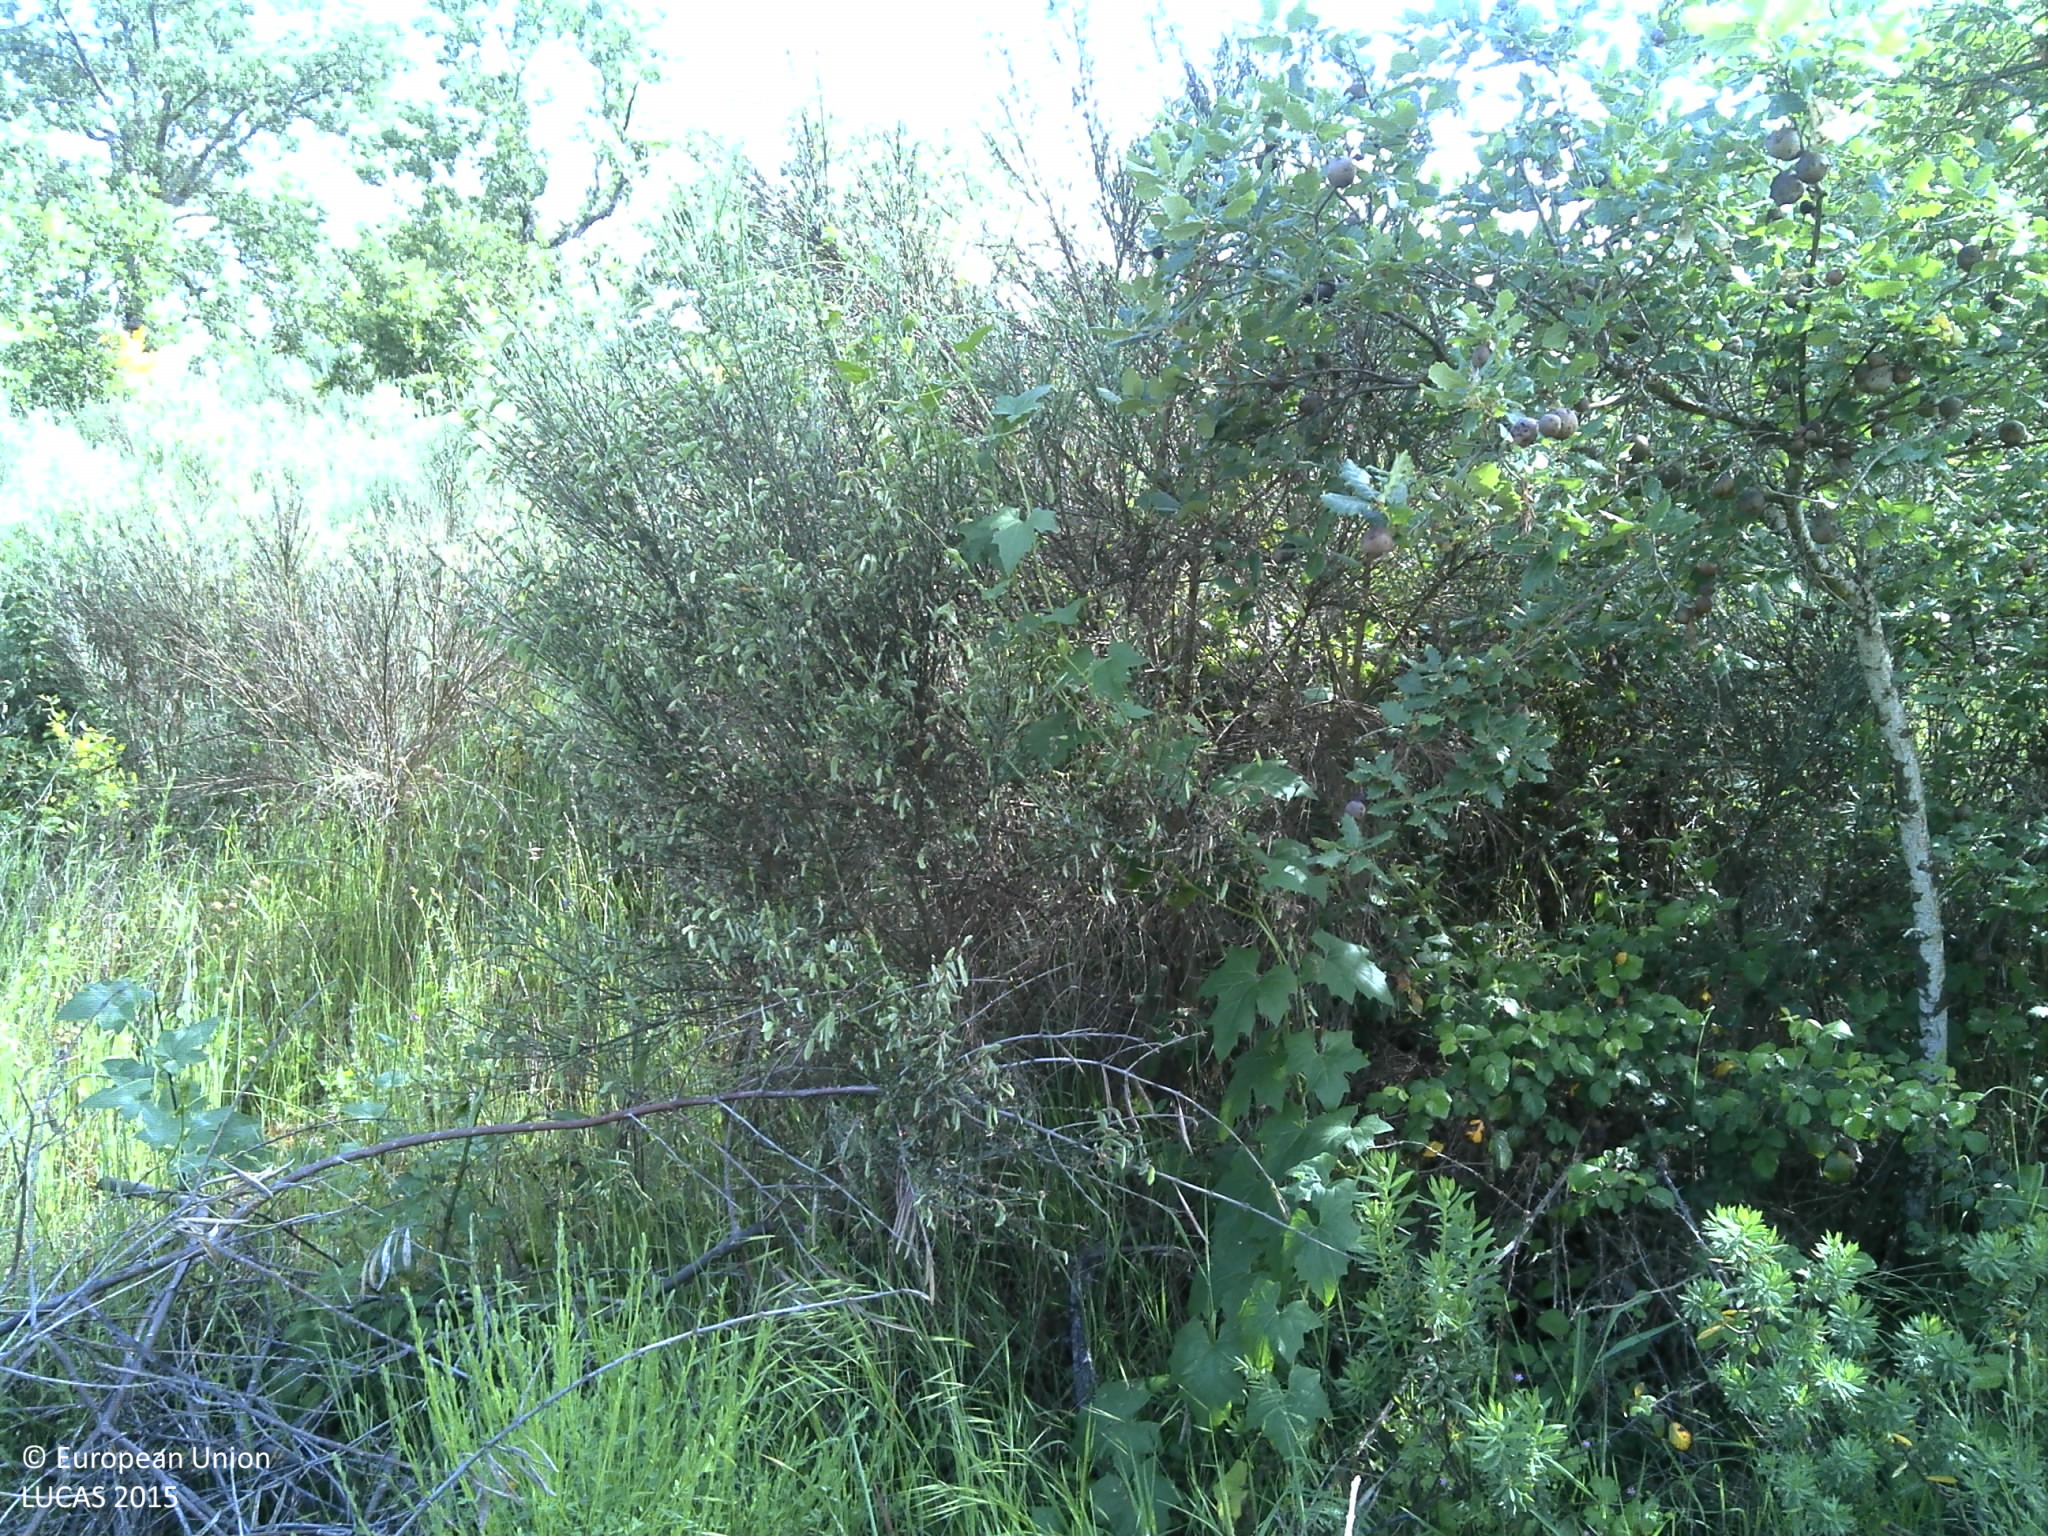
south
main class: Woodland
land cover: Broadleaved woodland
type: thermophilous deciduous forest
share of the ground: 10 - 25 %
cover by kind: shrubs 70 %, broadleaved forest trees 15 %, herbaceous plants 10 %, unconsolidated bare surface 5 %
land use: Forestry
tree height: > 5 m
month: May
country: PT
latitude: 41.6016
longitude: -7.0468
